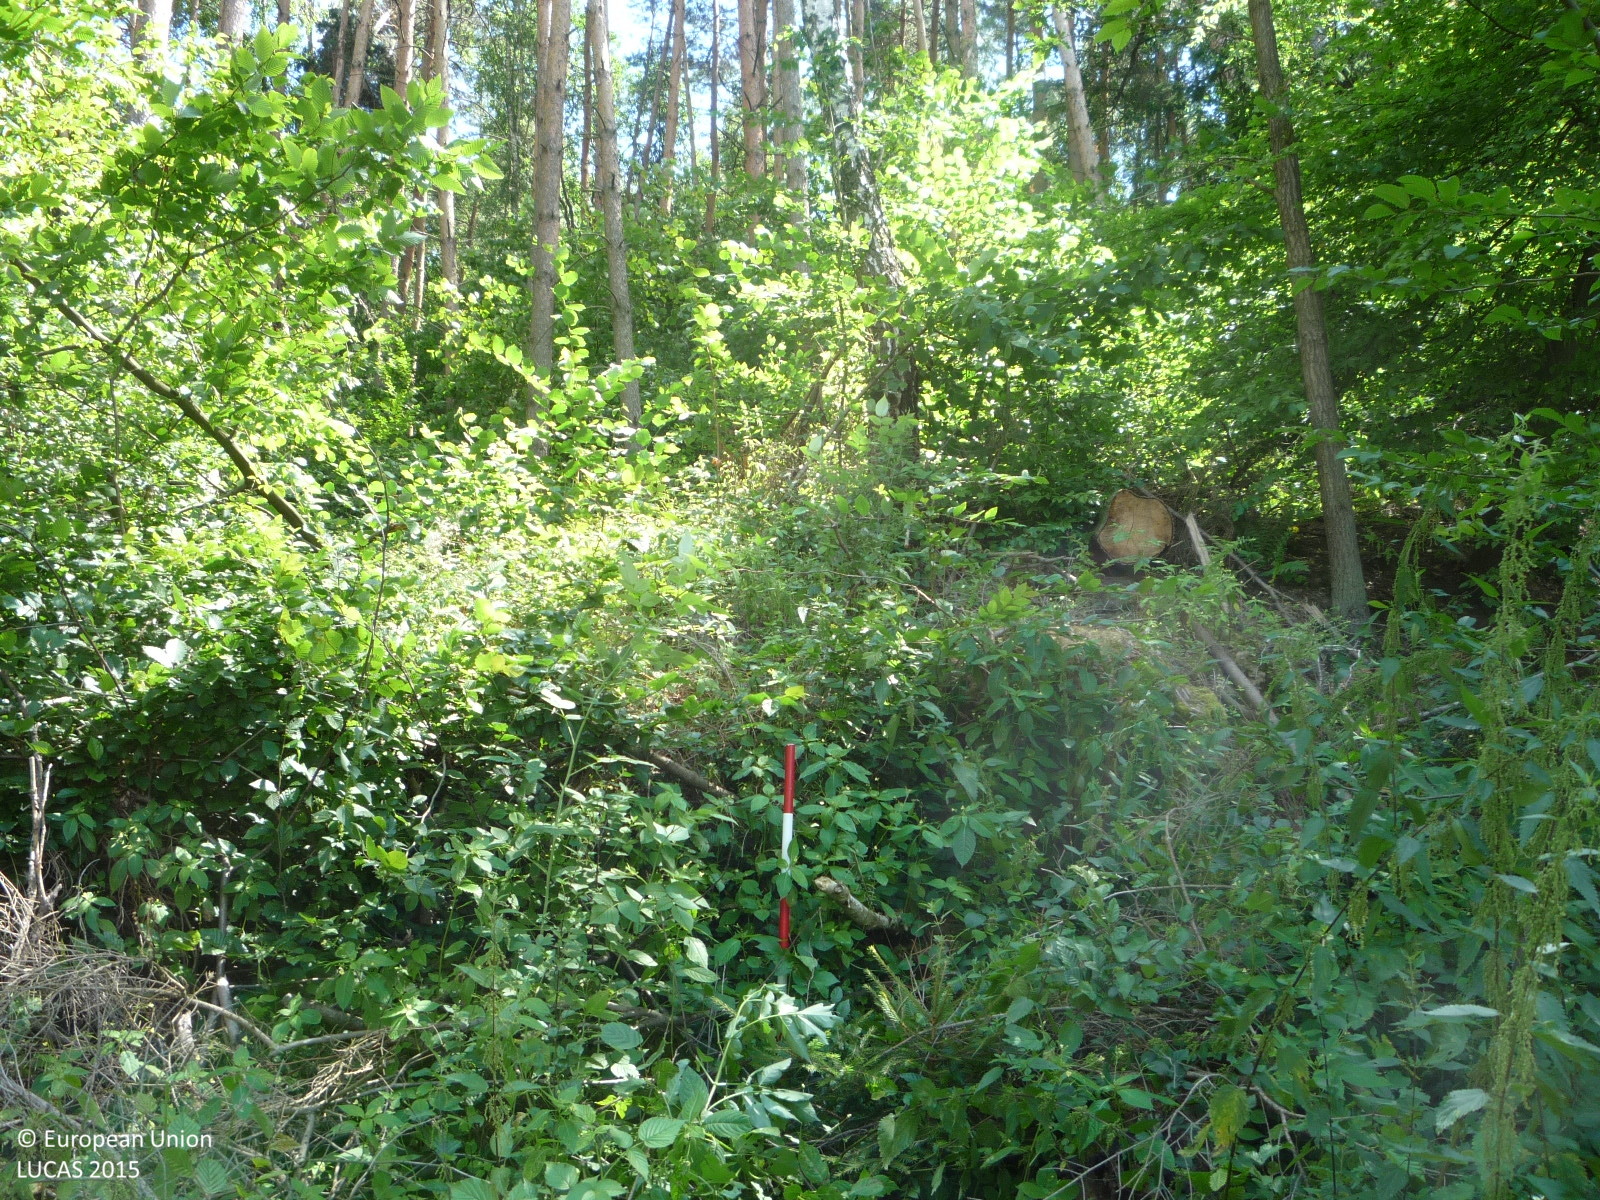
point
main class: Woodland
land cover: Other mixed woodland
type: hemiboreal forest and nemoral coniferous forest and mixed broadleaved-coniferous forest
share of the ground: > 75 %
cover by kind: coniferous forest trees 50 %, broadleaved forest trees 30 %, herbaceous plants 20 %
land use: Forestry
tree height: > 5 m
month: July
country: CZ
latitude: 50.5456
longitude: 14.5035
